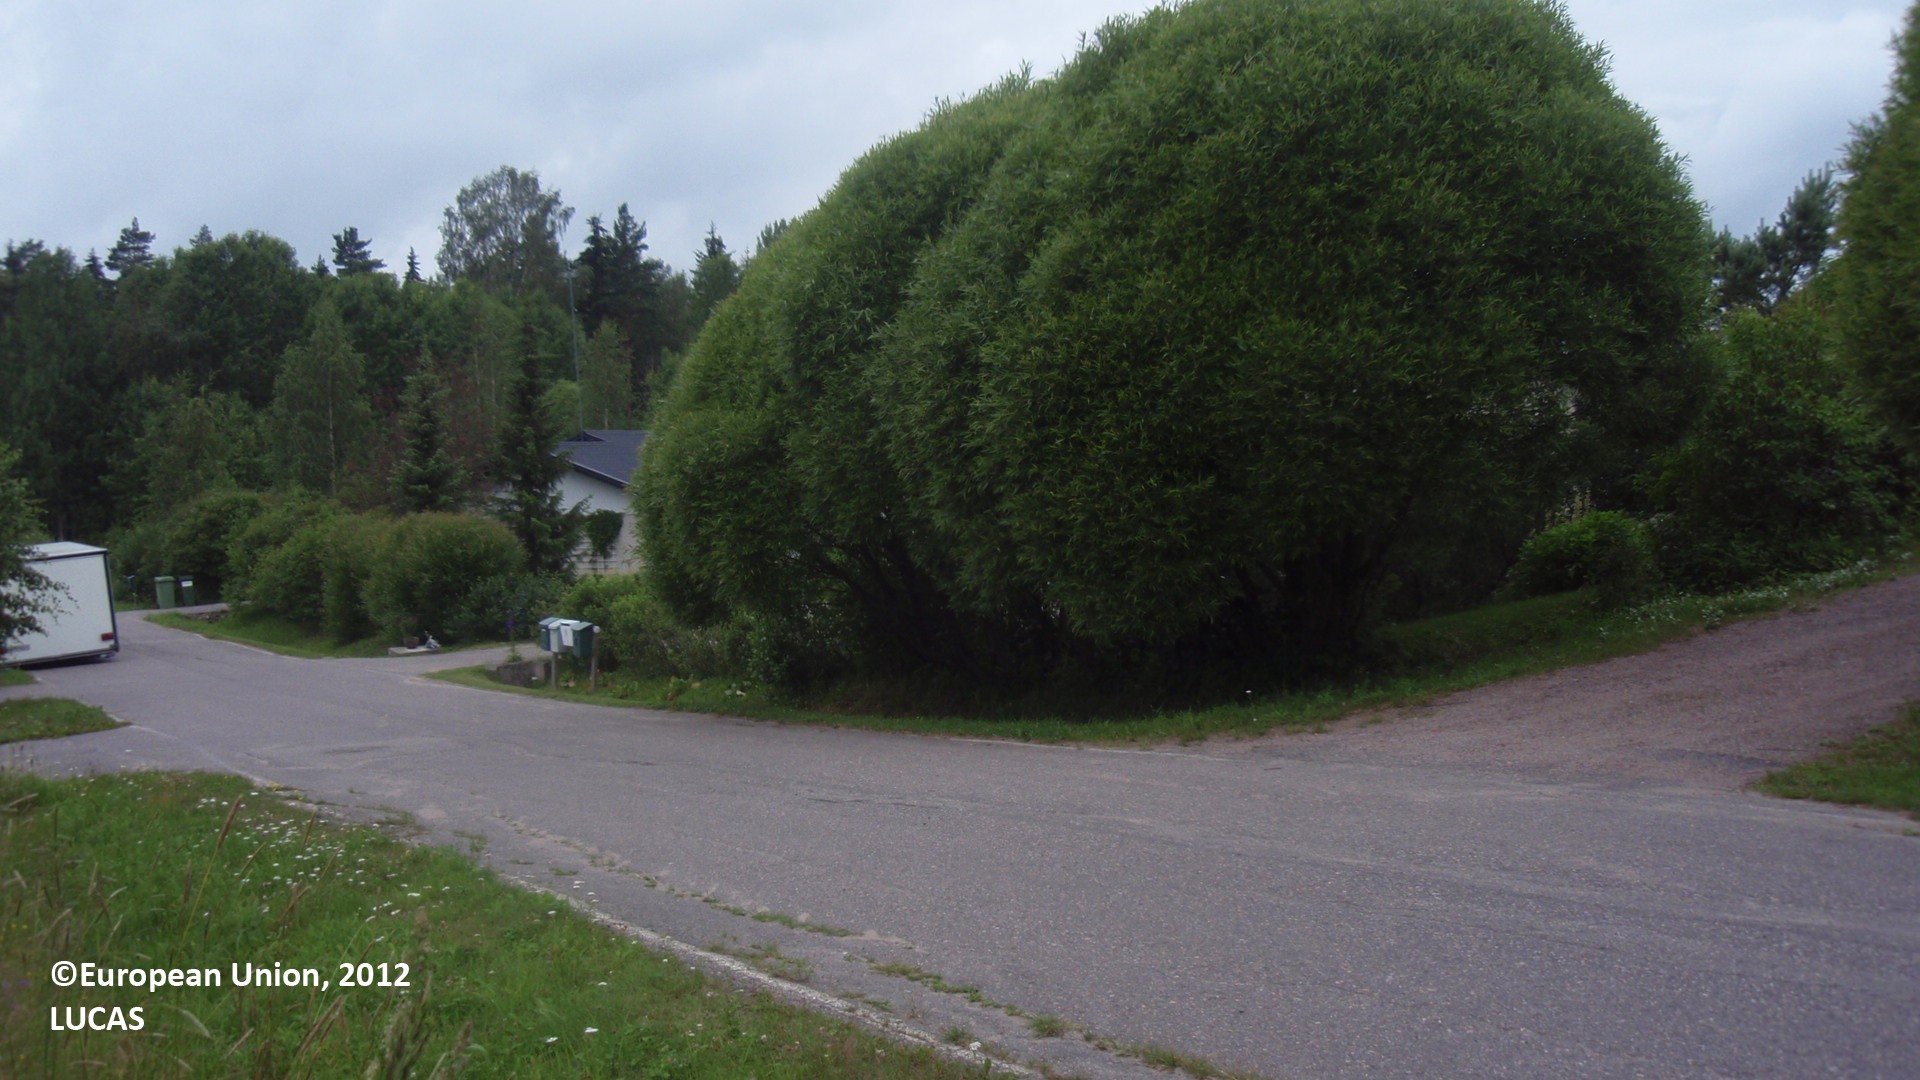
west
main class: Grassland
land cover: Grassland with sparse tree/shrub cover
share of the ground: > 75 %
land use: Residential
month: July
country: FI
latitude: 61.1552
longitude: 28.7504
